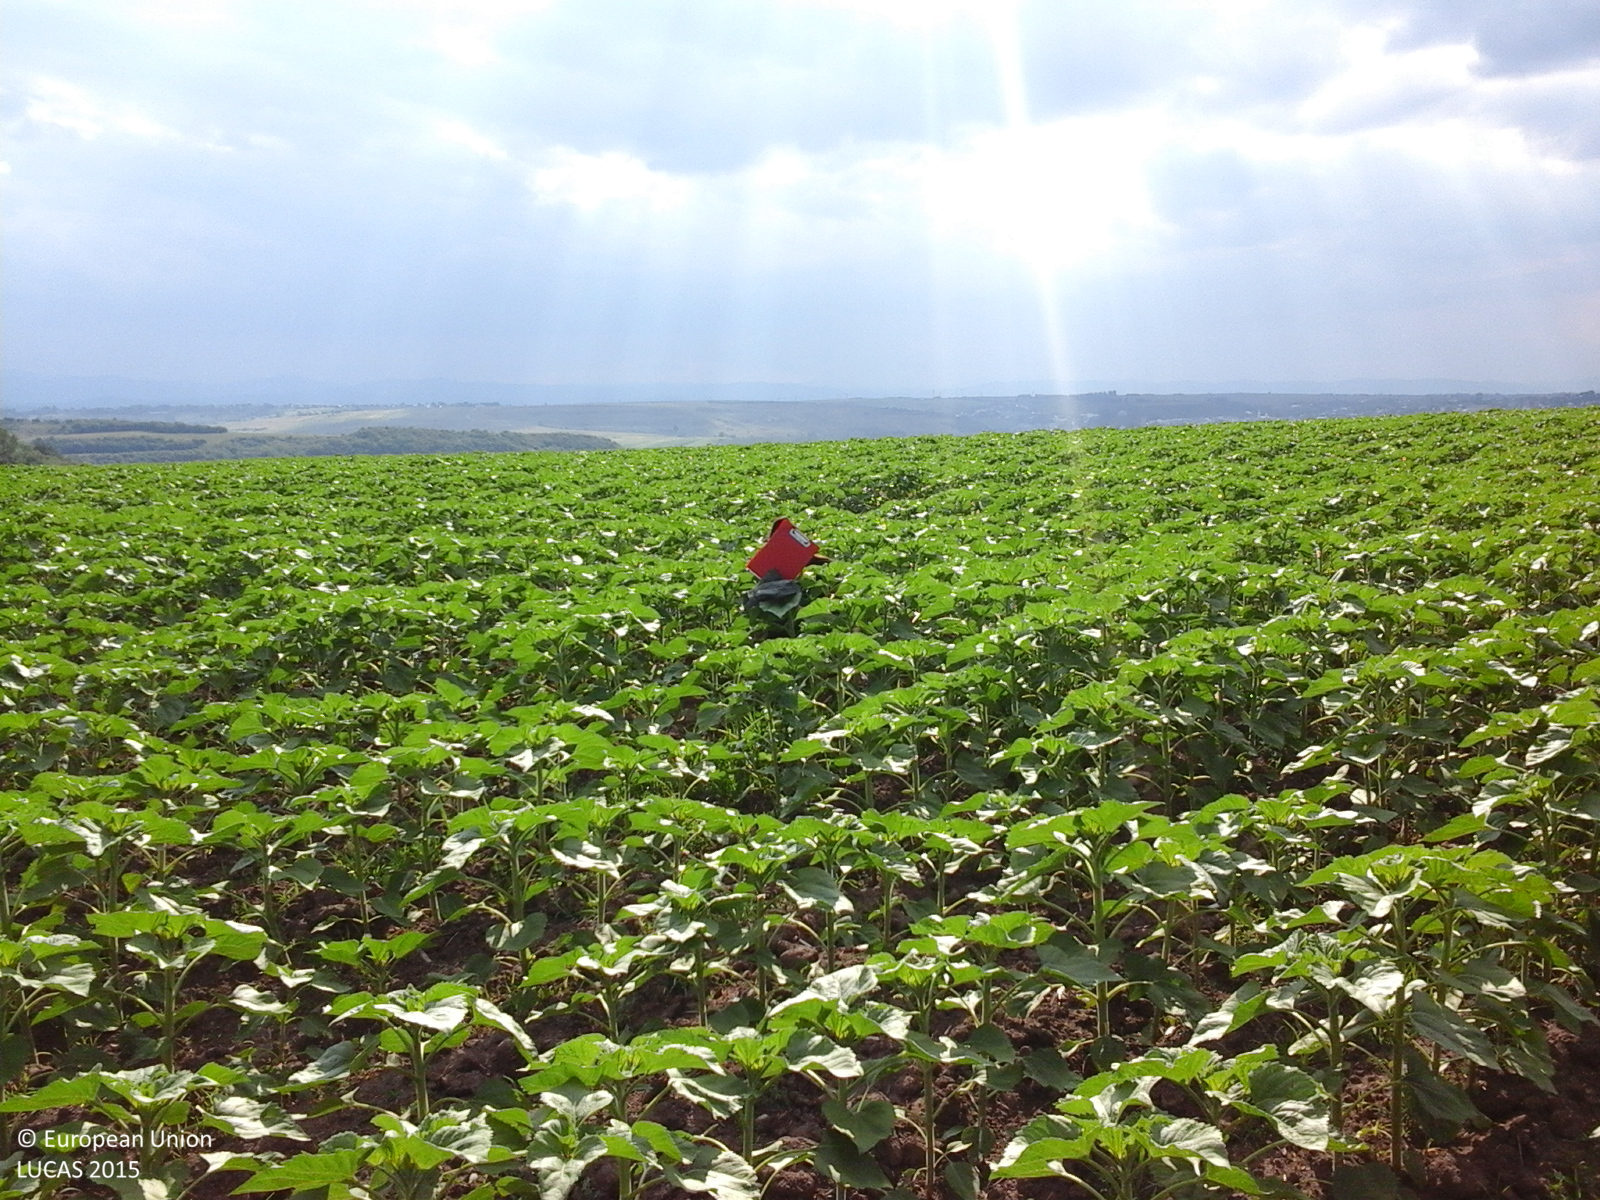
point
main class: Cropland
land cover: Sunflower
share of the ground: > 75 %
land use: Agriculture (excluding fallow land and kitchen gardens)
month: June
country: RO
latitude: 47.4496
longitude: 26.3578
